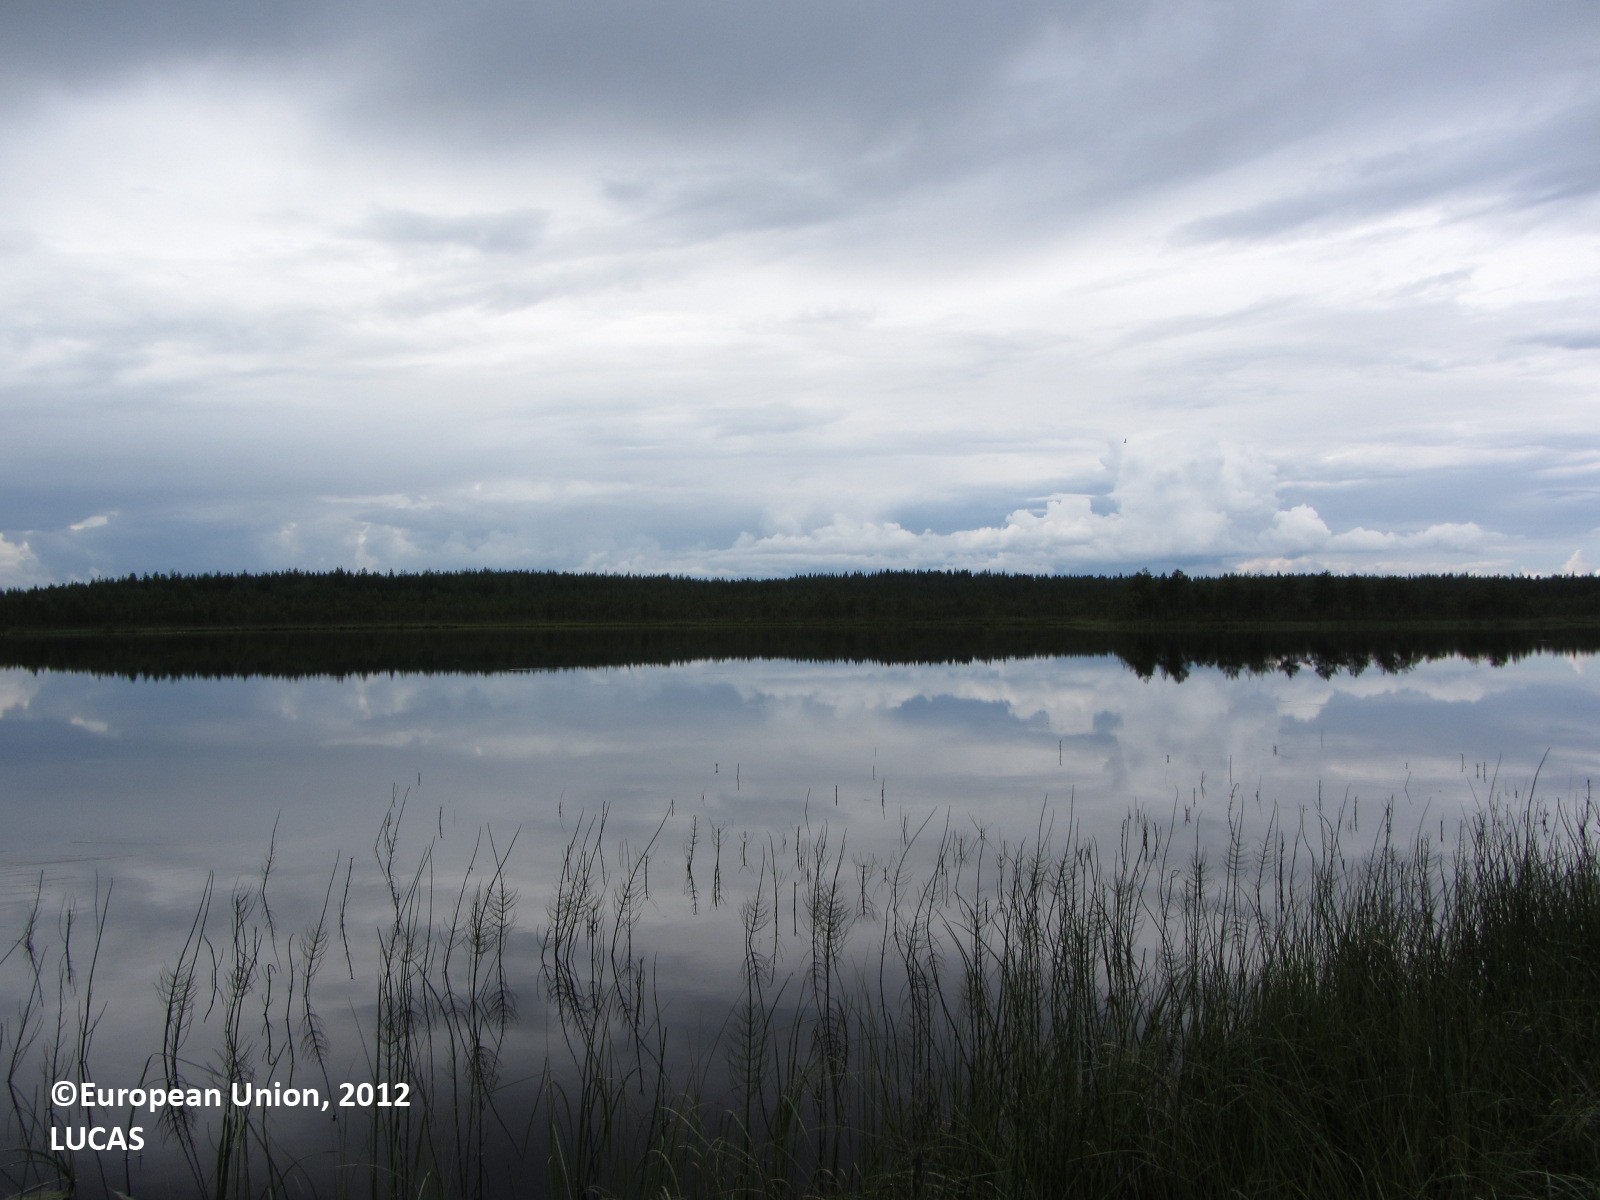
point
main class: Woodland
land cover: Pine dominated coniferous woodland
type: boreal forest
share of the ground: 50 - 75 %
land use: Forestry
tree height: > 5 m
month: July
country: FI
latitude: 63.5893
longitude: 25.3511
